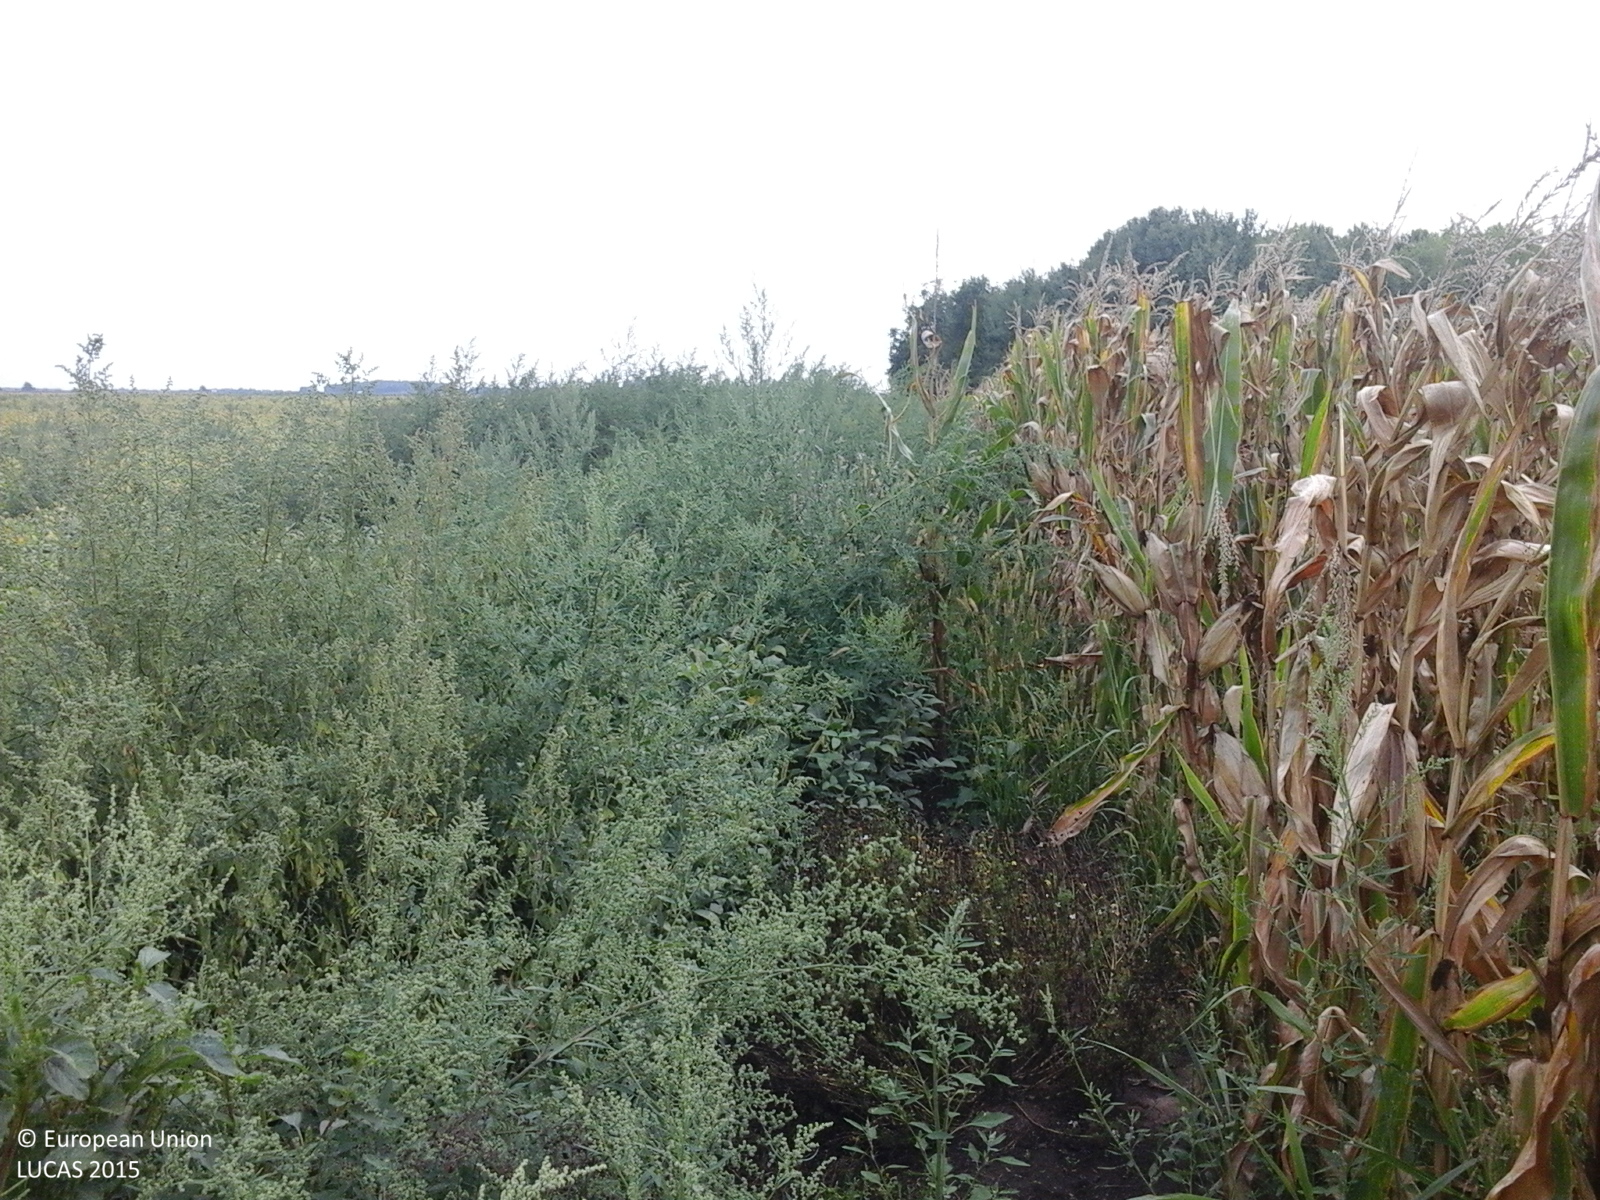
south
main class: Cropland
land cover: Maize
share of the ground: > 75 %
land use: Agriculture (excluding fallow land and kitchen gardens)
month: August
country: RO
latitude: 46.3734
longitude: 21.2533
